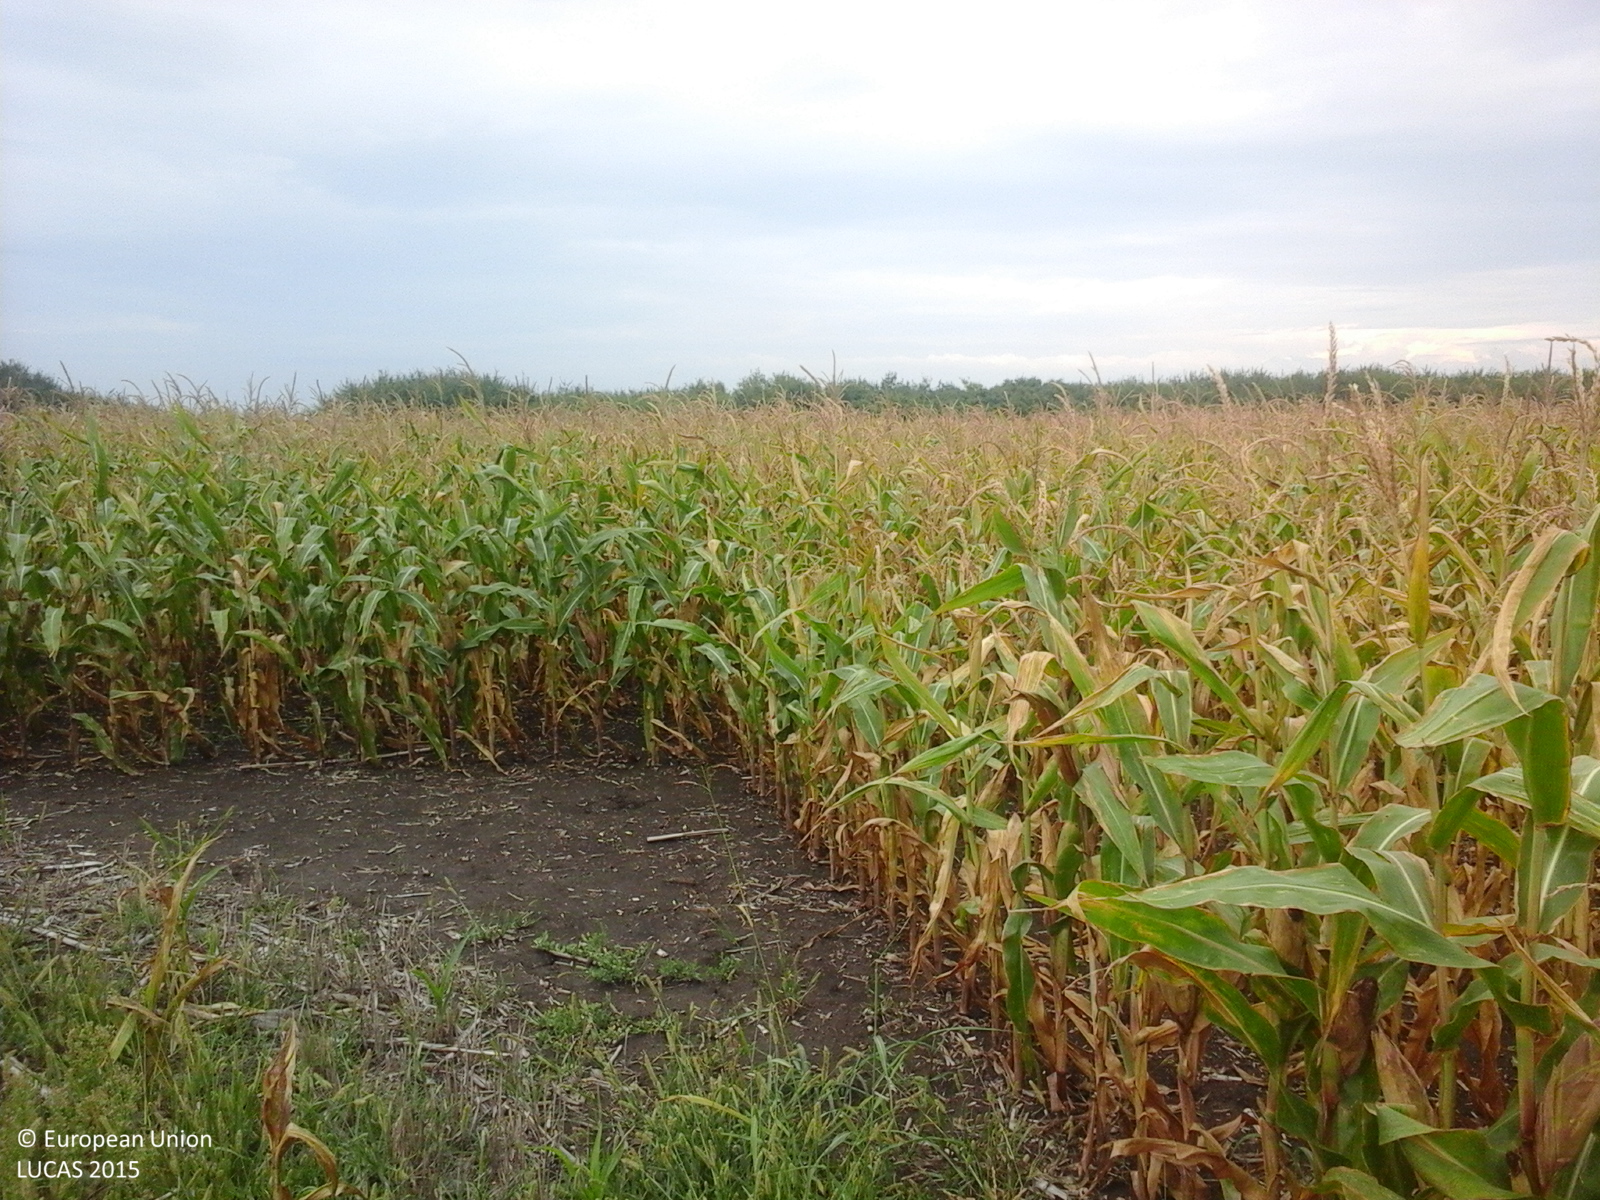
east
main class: Cropland
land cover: Maize
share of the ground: > 75 %
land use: Agriculture (excluding fallow land and kitchen gardens)
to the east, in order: Maize; Abandoned hedges; Ditches and canals; Abandoned hedges; Common wheat
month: August
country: RO
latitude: 46.0274
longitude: 20.5536
